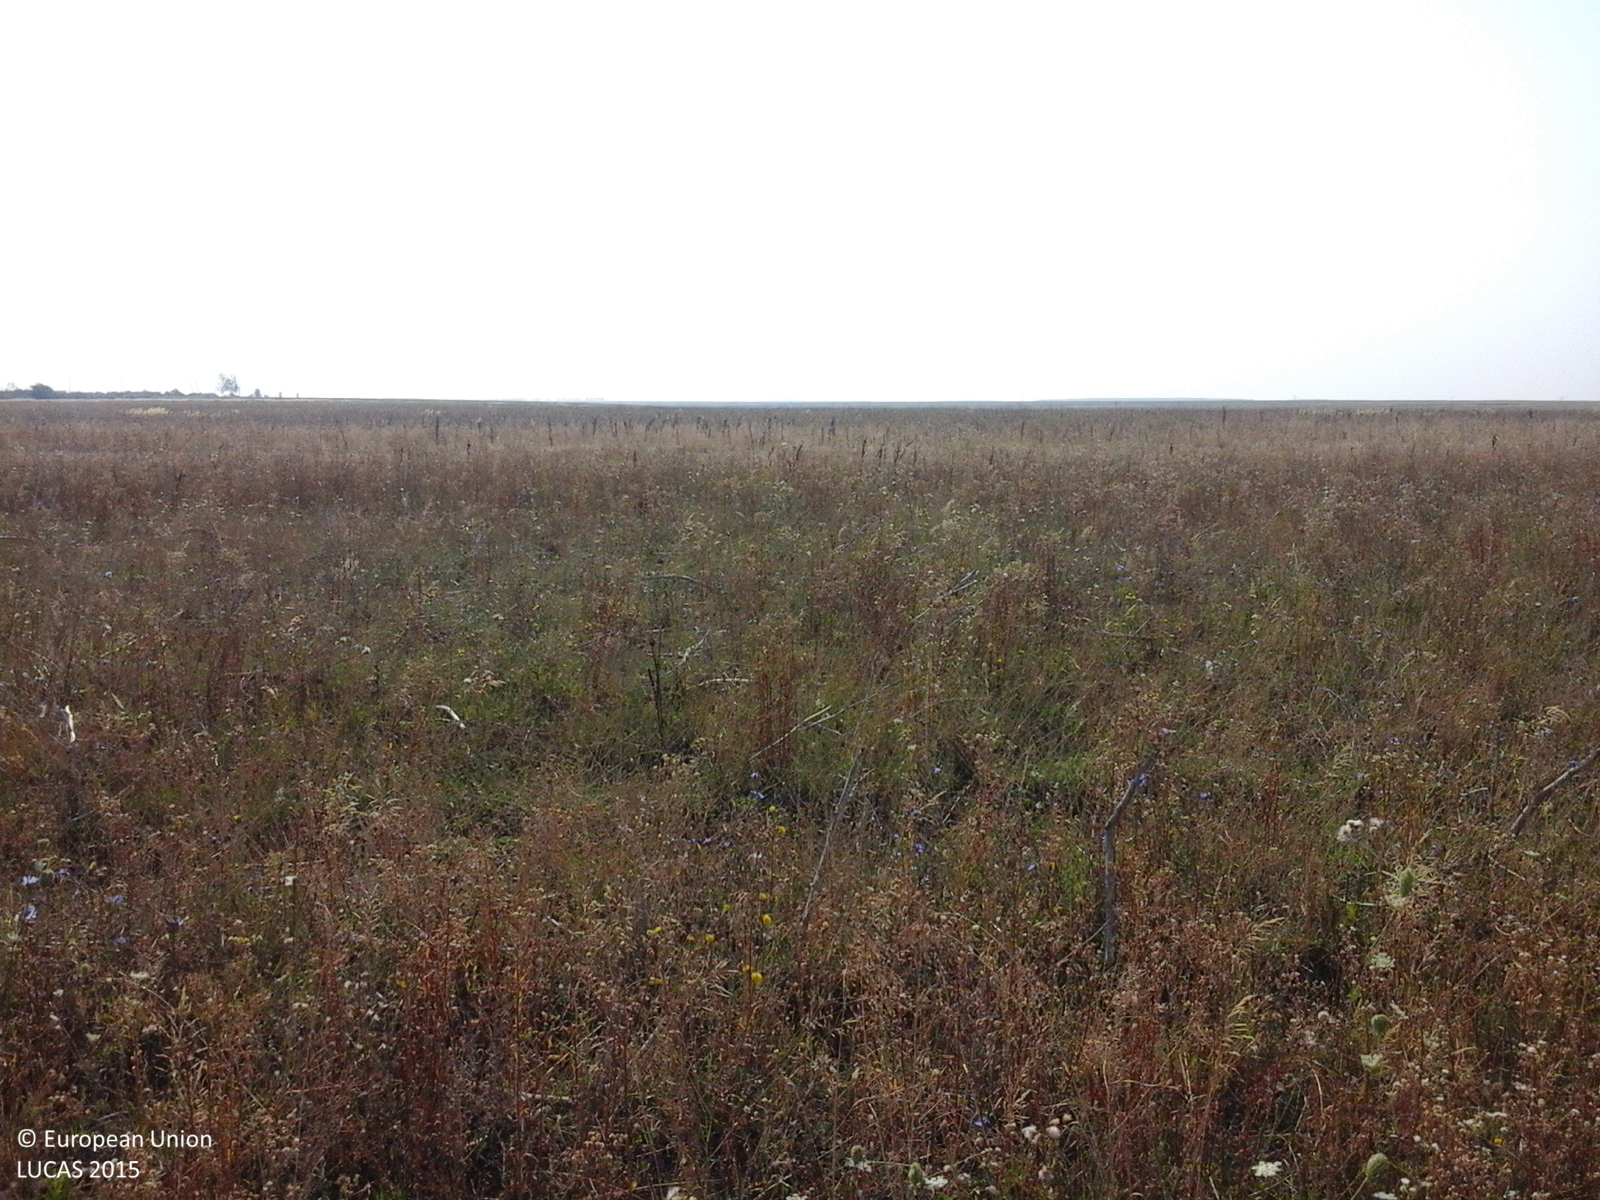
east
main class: Grassland
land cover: Spontaneously vegetated surfaces
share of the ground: > 75 %
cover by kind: herbaceous plants 100 %
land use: Fallow land
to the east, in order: Spontaneously vegetated surfaces; Common wheat; Spontaneously vegetated surfaces
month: August
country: RO
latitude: 44.4725
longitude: 23.1849
